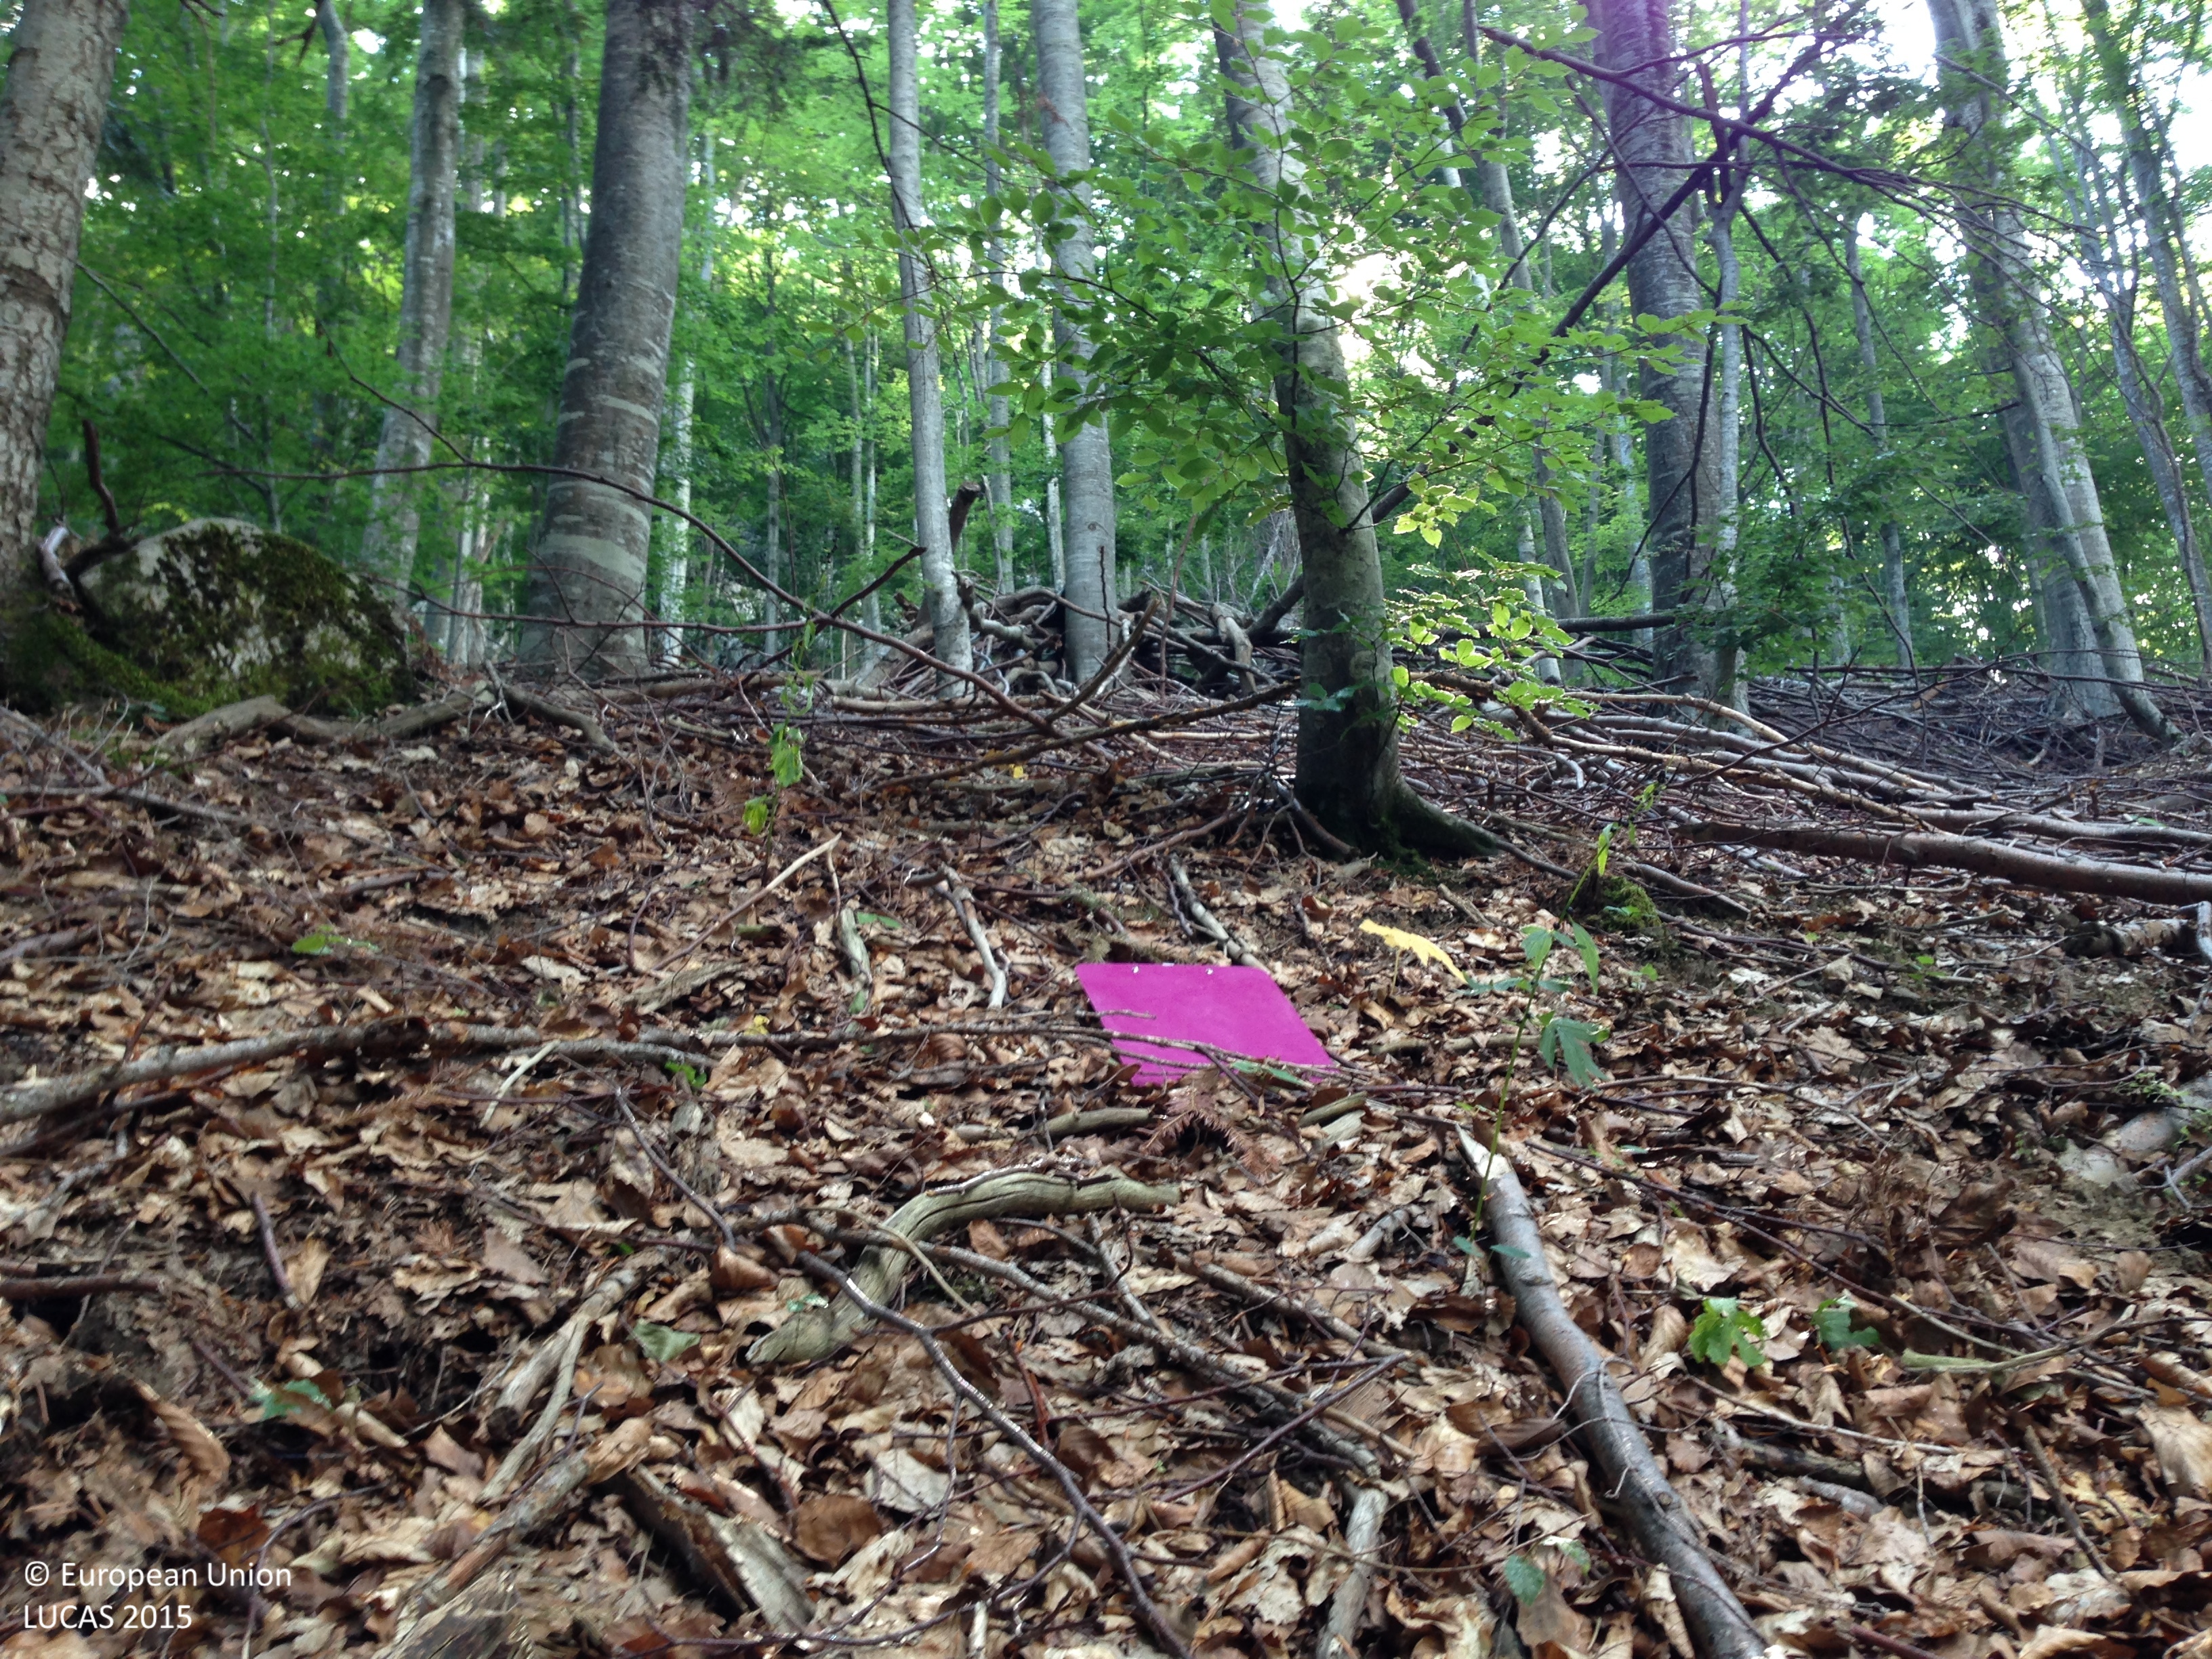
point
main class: Woodland
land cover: Other mixed woodland
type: mountainous beech forest
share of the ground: > 75 %
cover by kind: broadleaved forest trees 60 %, coniferous forest trees 20 %, lichens and mosses 10 %, shrubs 5 %, unconsolidated bare surface 5 %
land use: Forestry
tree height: > 5 m
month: July
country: HR
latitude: 44.6203
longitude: 15.1480
